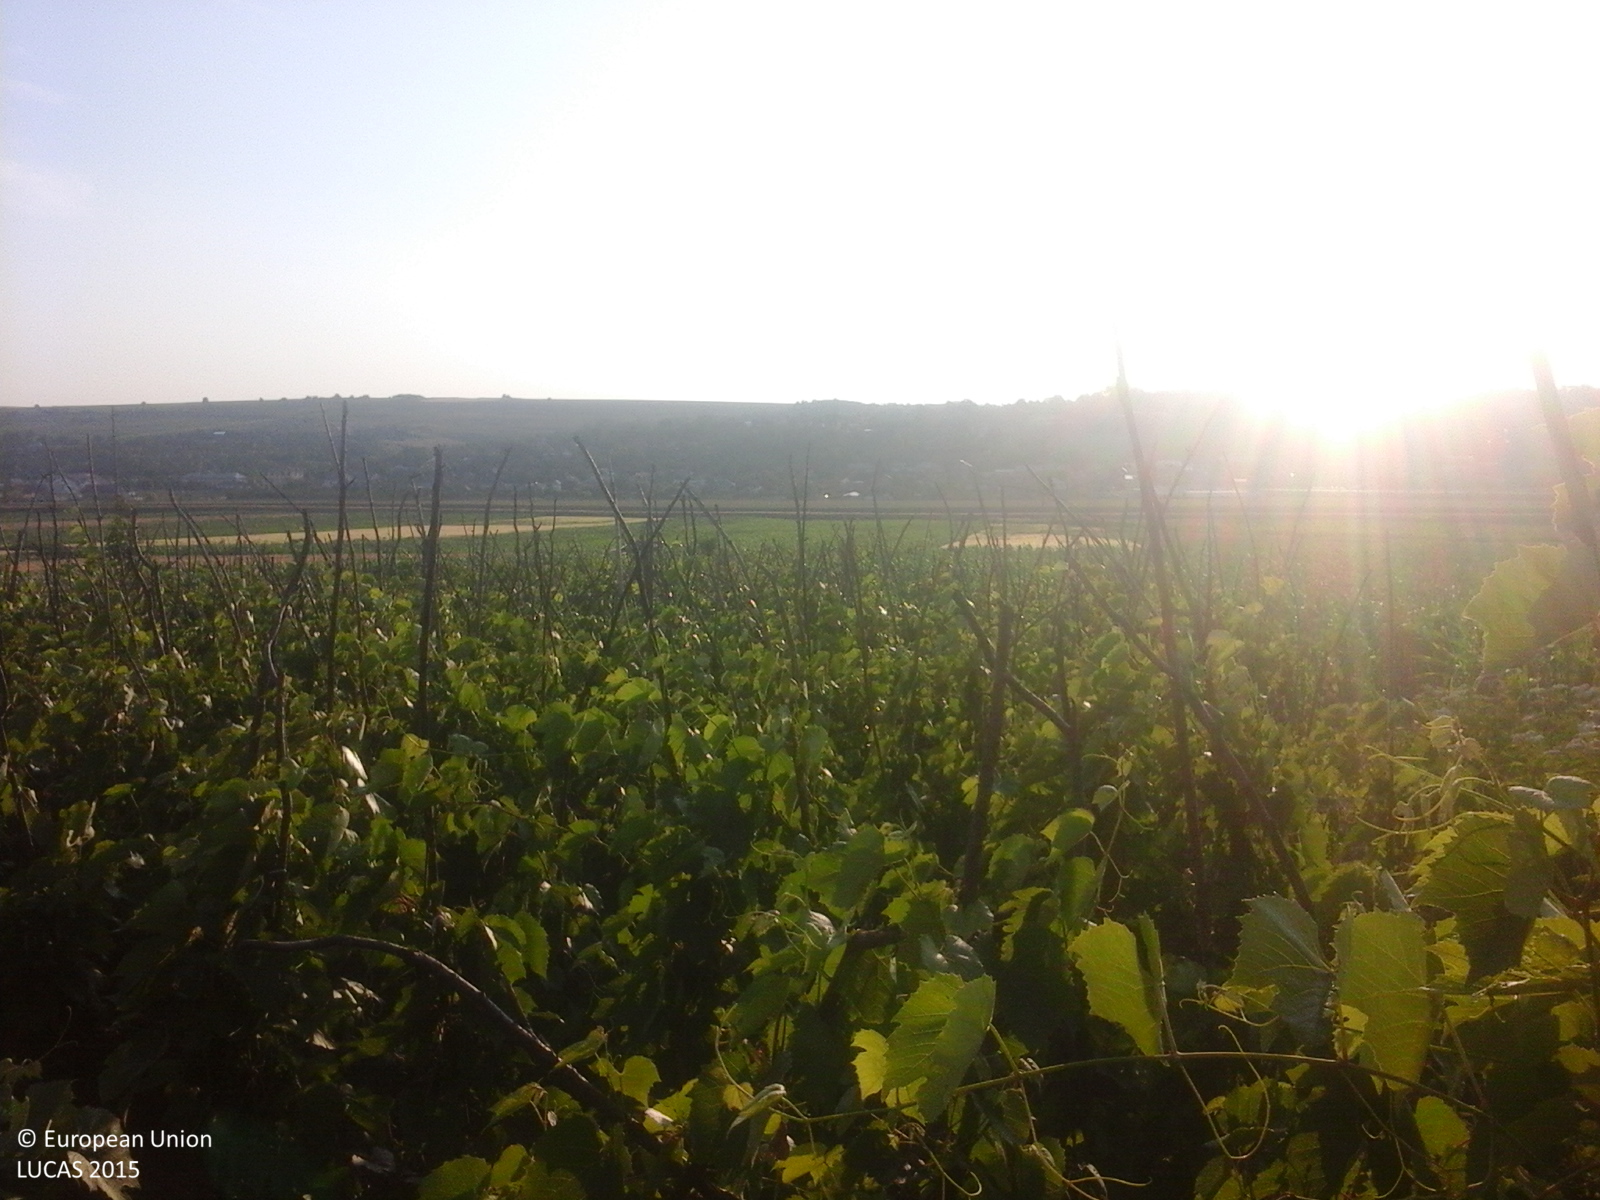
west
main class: Shrubland
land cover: Shrubland with sparse tree cover
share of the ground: > 75 %
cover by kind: shrubs 95 %, broadleaved forest trees 5 %
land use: Semi-natural and natural areas not in use
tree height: < 5 m
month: June
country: RO
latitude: 46.7442
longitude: 27.7782
